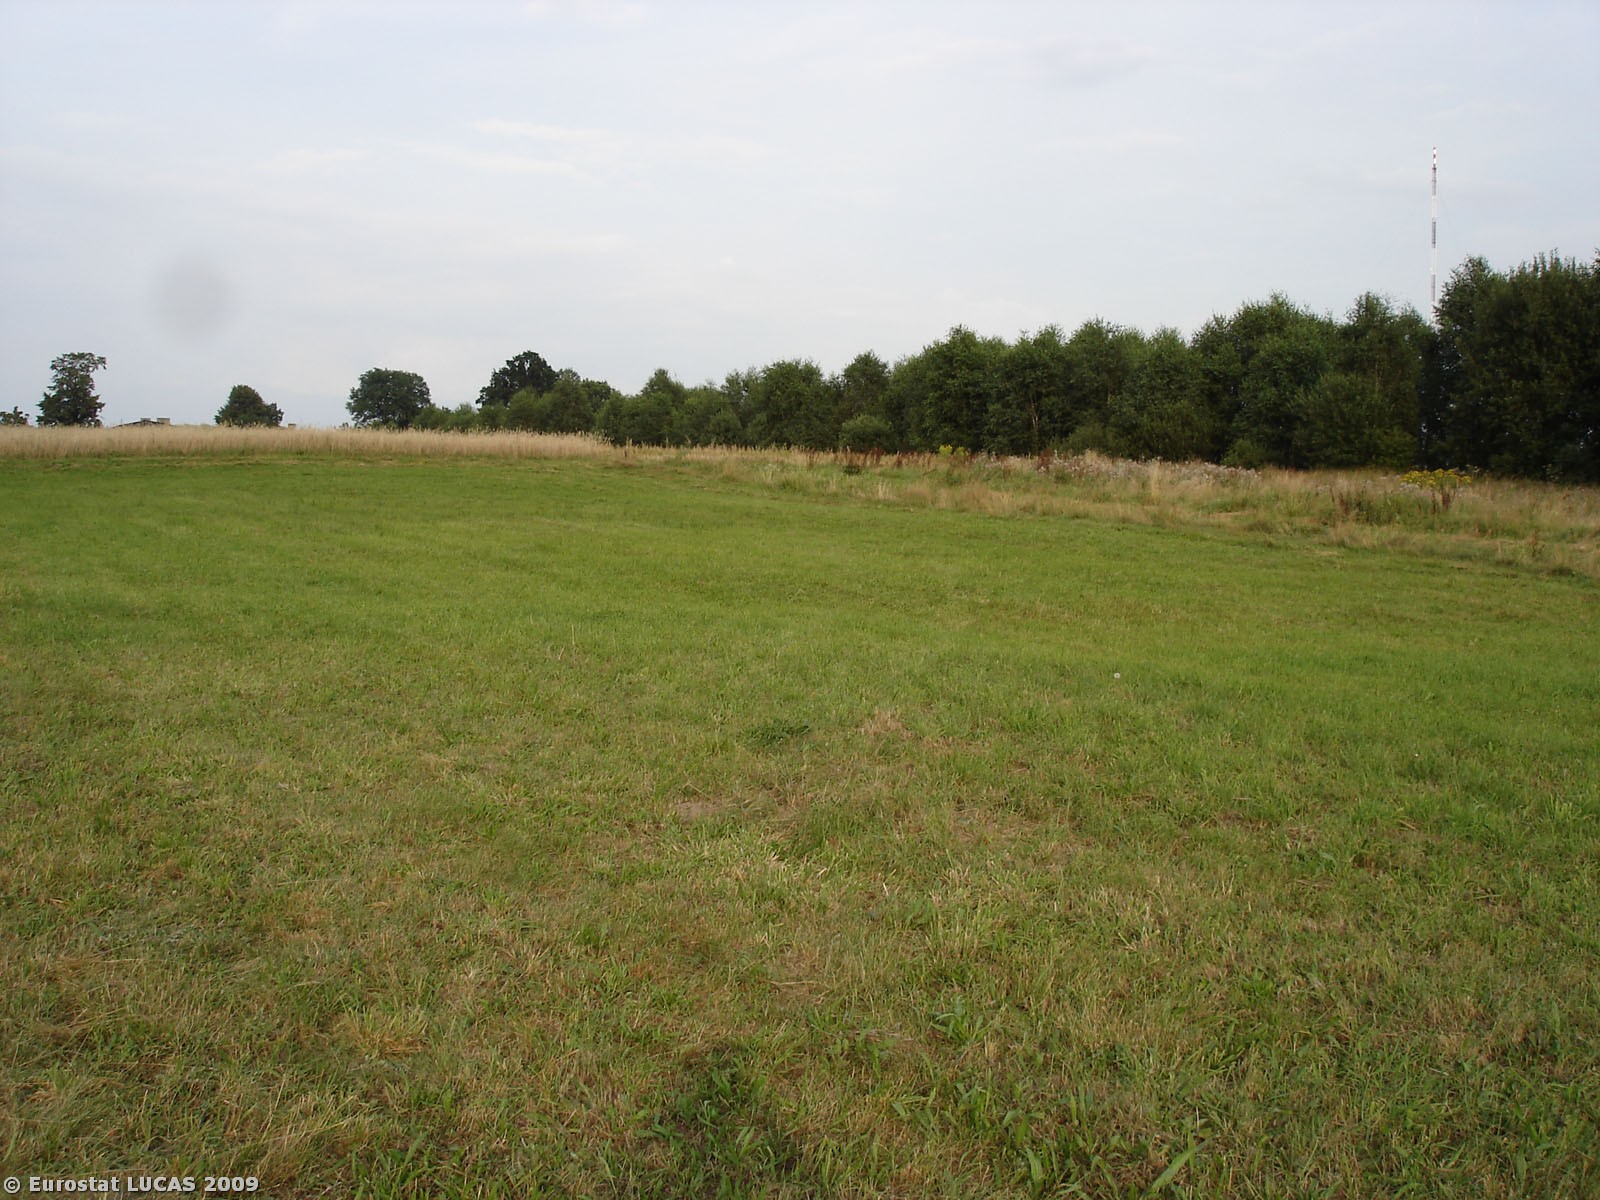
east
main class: Grassland
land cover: Grassland without tree/shrub cover
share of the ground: > 75 %
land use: Agriculture (excluding fallow land and kitchen gardens)
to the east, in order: Grassland without tree/shrub cover; Tracks; Barley; Grassland without tree/shrub cover; Broadleaved woodland; Grass margins; Rye
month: August
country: PL
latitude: 50.8531
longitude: 18.8432
